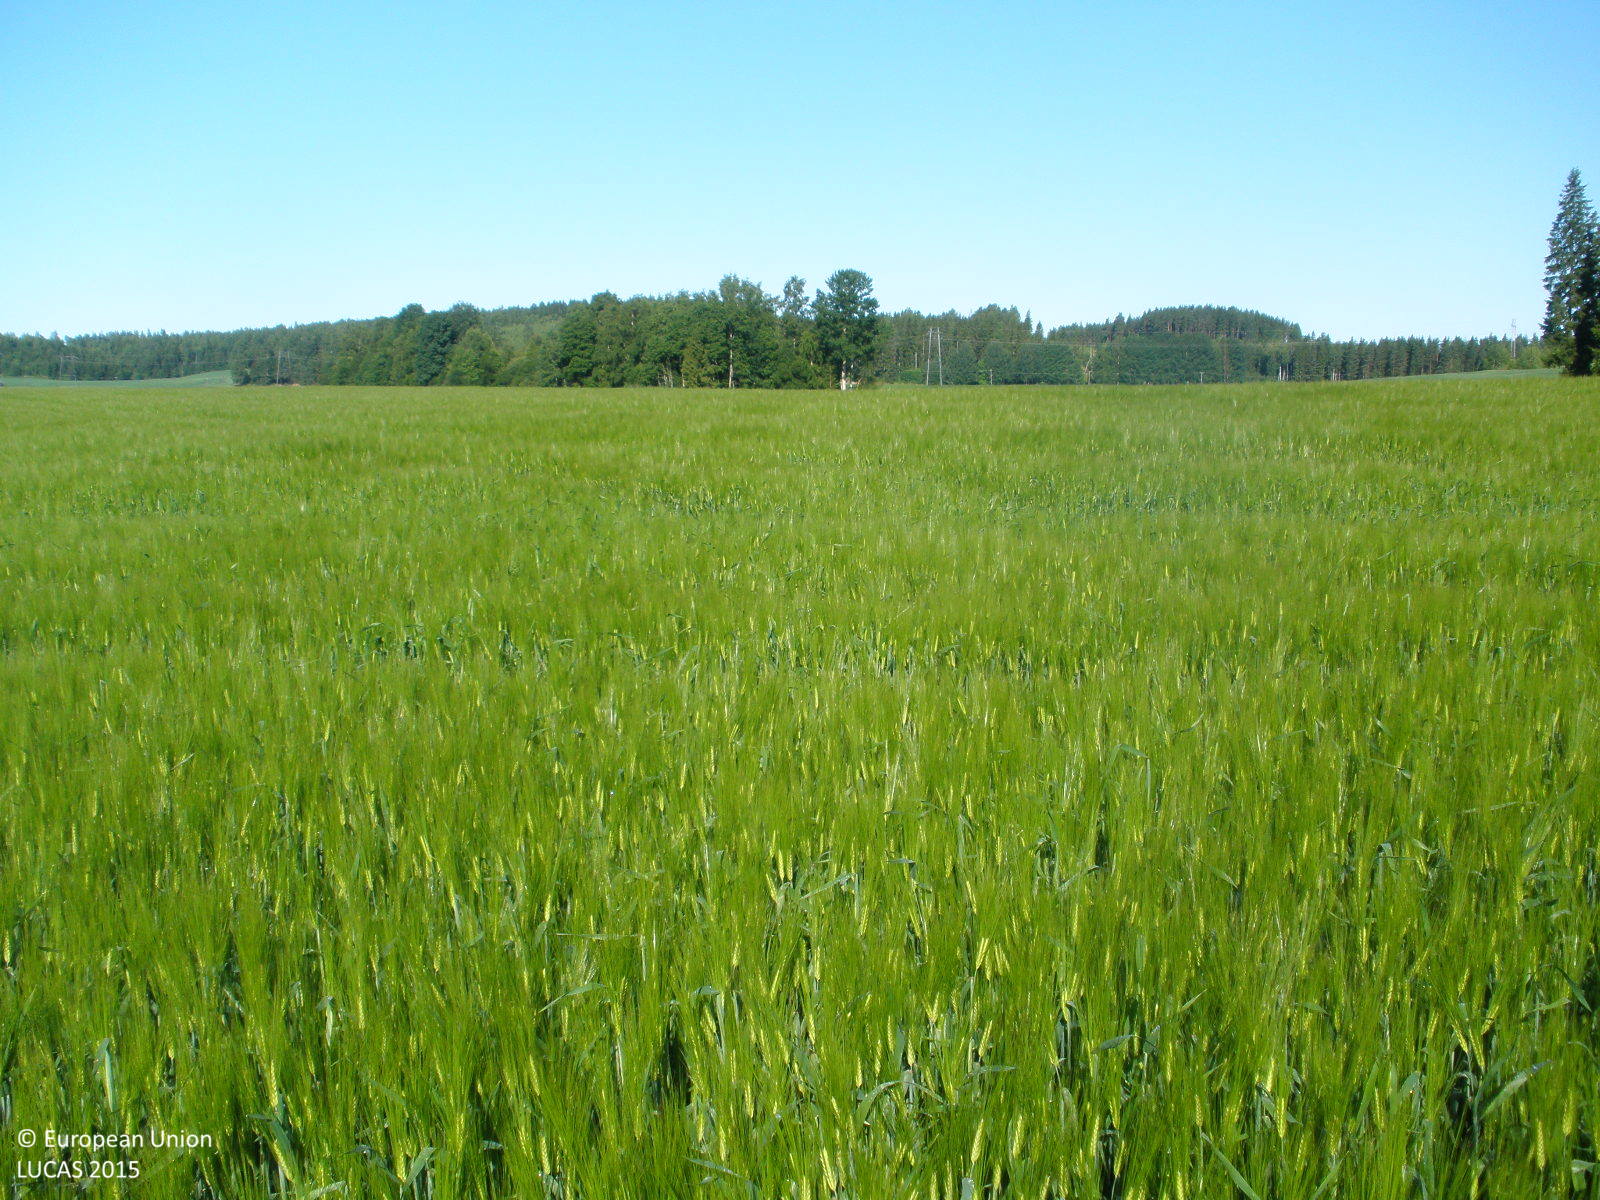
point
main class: Cropland
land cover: Barley
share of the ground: > 75 %
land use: Agriculture (excluding fallow land and kitchen gardens)
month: July
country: FI
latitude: 61.0100
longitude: 25.1548
